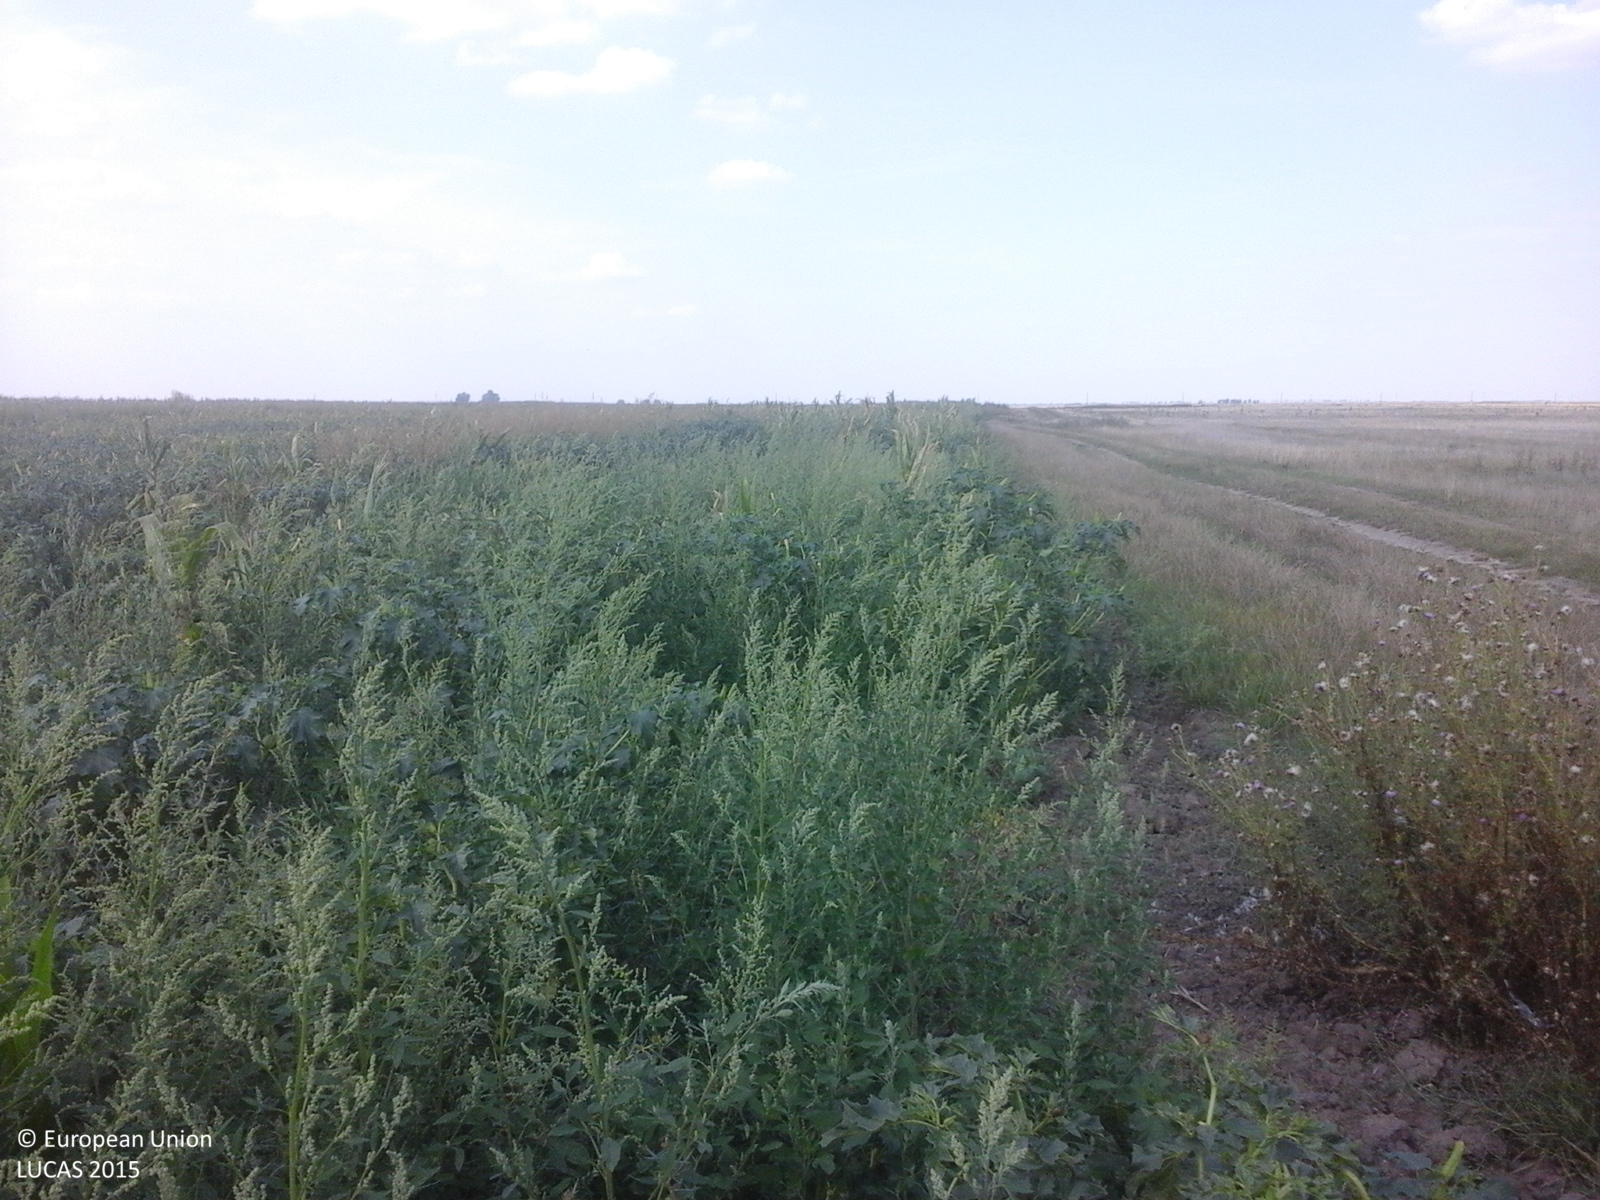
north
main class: Grassland
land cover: Spontaneously vegetated surfaces
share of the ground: > 75 %
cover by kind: herbaceous plants 100 %
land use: Fallow land
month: August
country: RO
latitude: 46.4158
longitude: 21.3676
